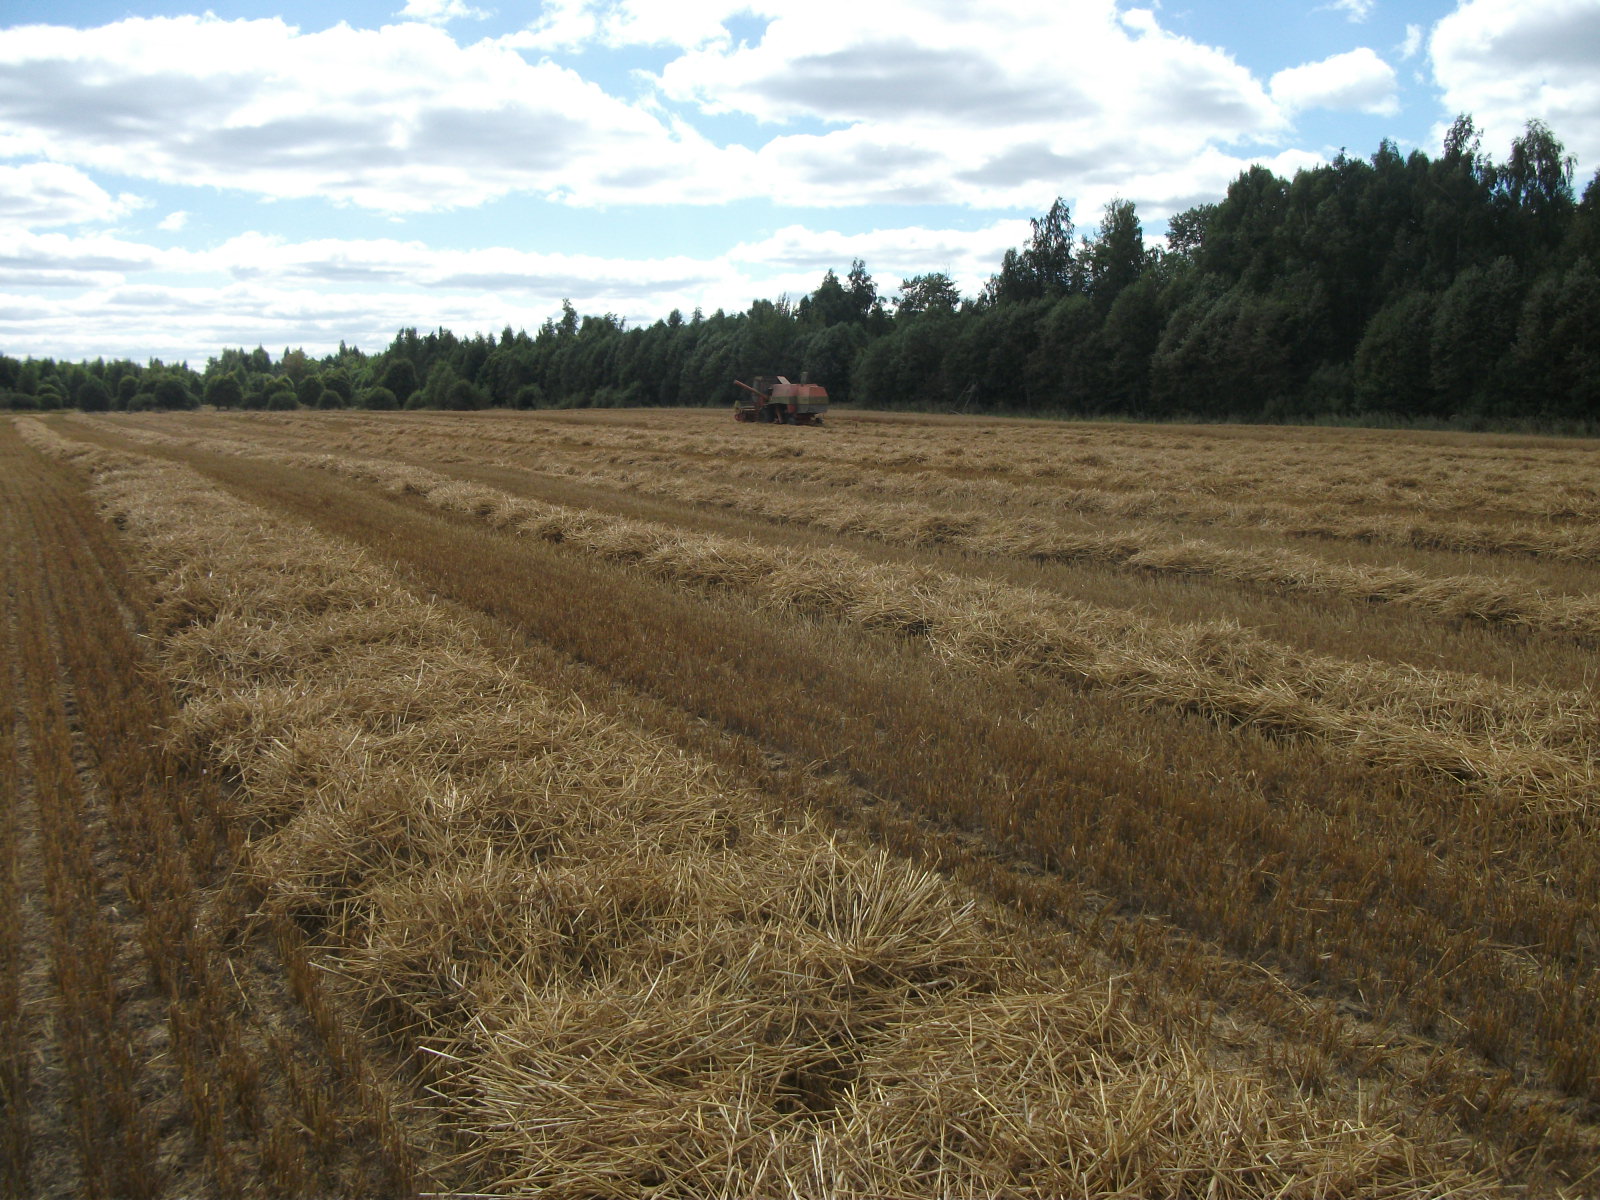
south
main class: Cropland
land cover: Barley
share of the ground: < 10 %
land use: Agriculture (excluding fallow land and kitchen gardens)
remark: Harvested field
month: August
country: LV
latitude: 56.5745
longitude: 26.4057
